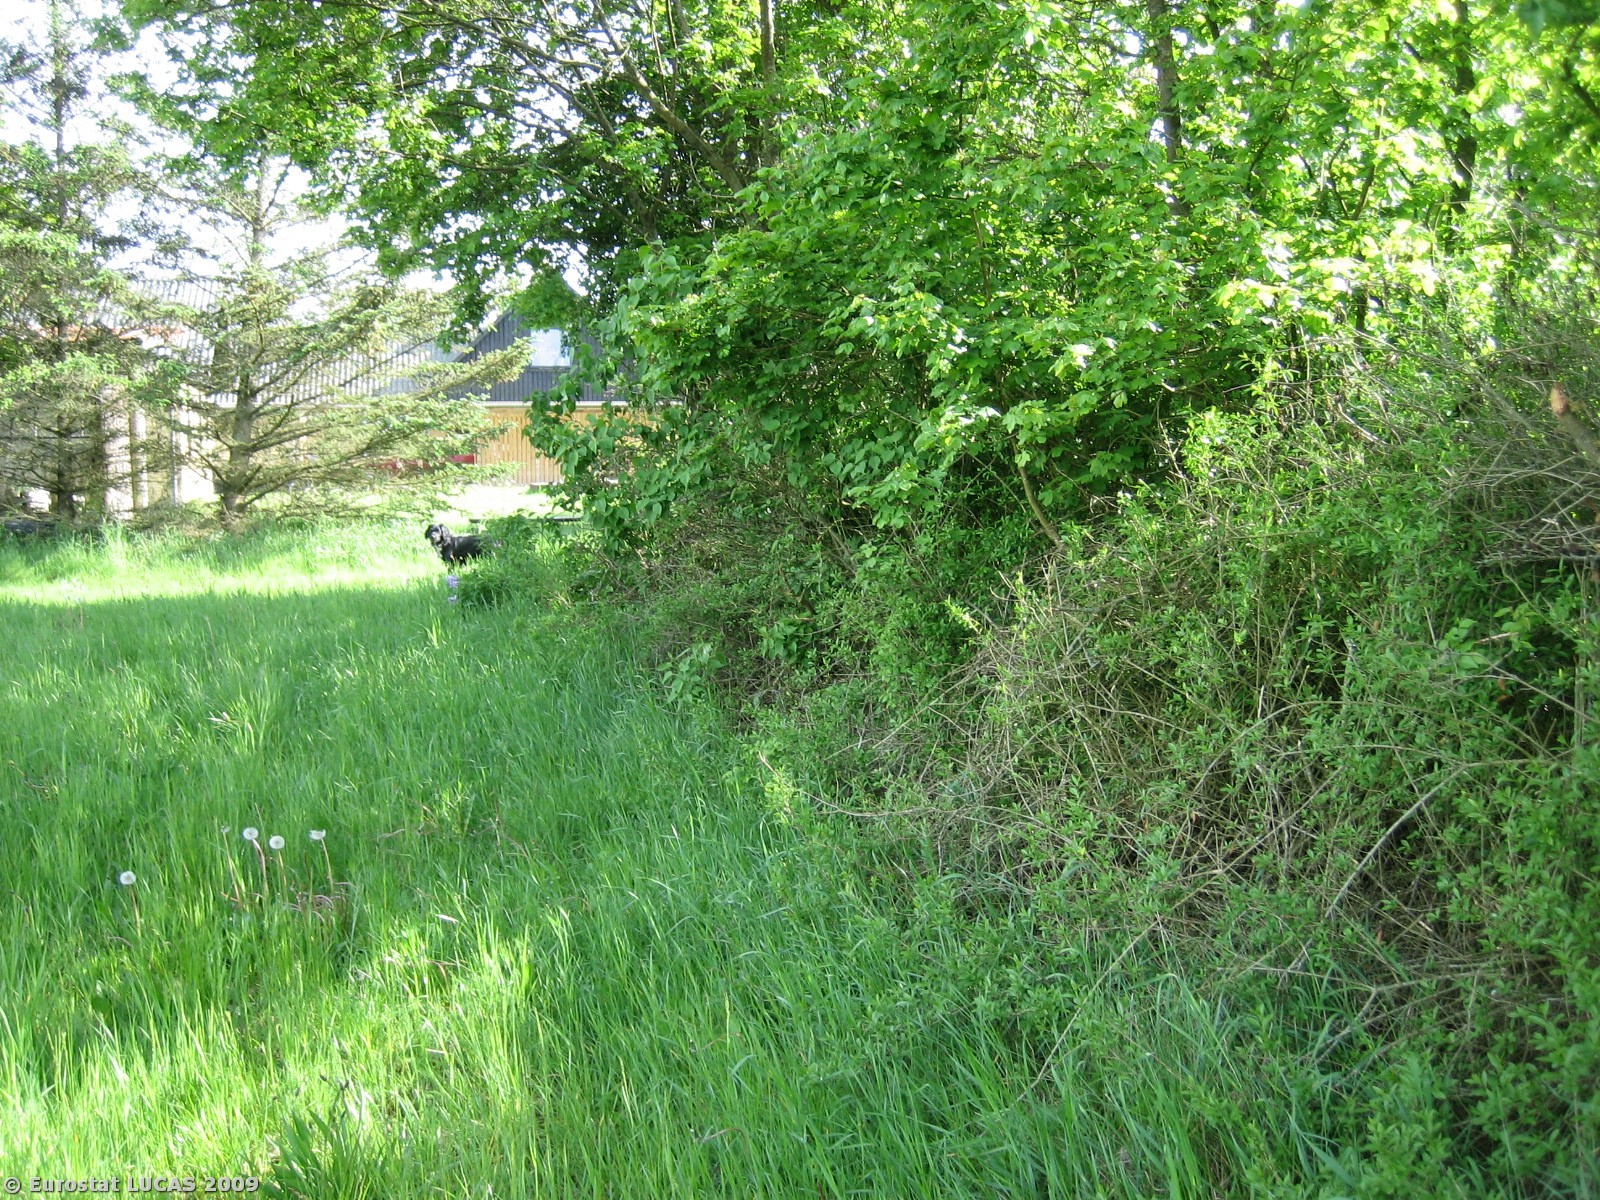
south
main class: Grassland
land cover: Grassland without tree/shrub cover
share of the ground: > 75 %
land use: Agriculture (excluding fallow land and kitchen gardens)
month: May
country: DK
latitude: 56.1859
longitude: 9.3080
